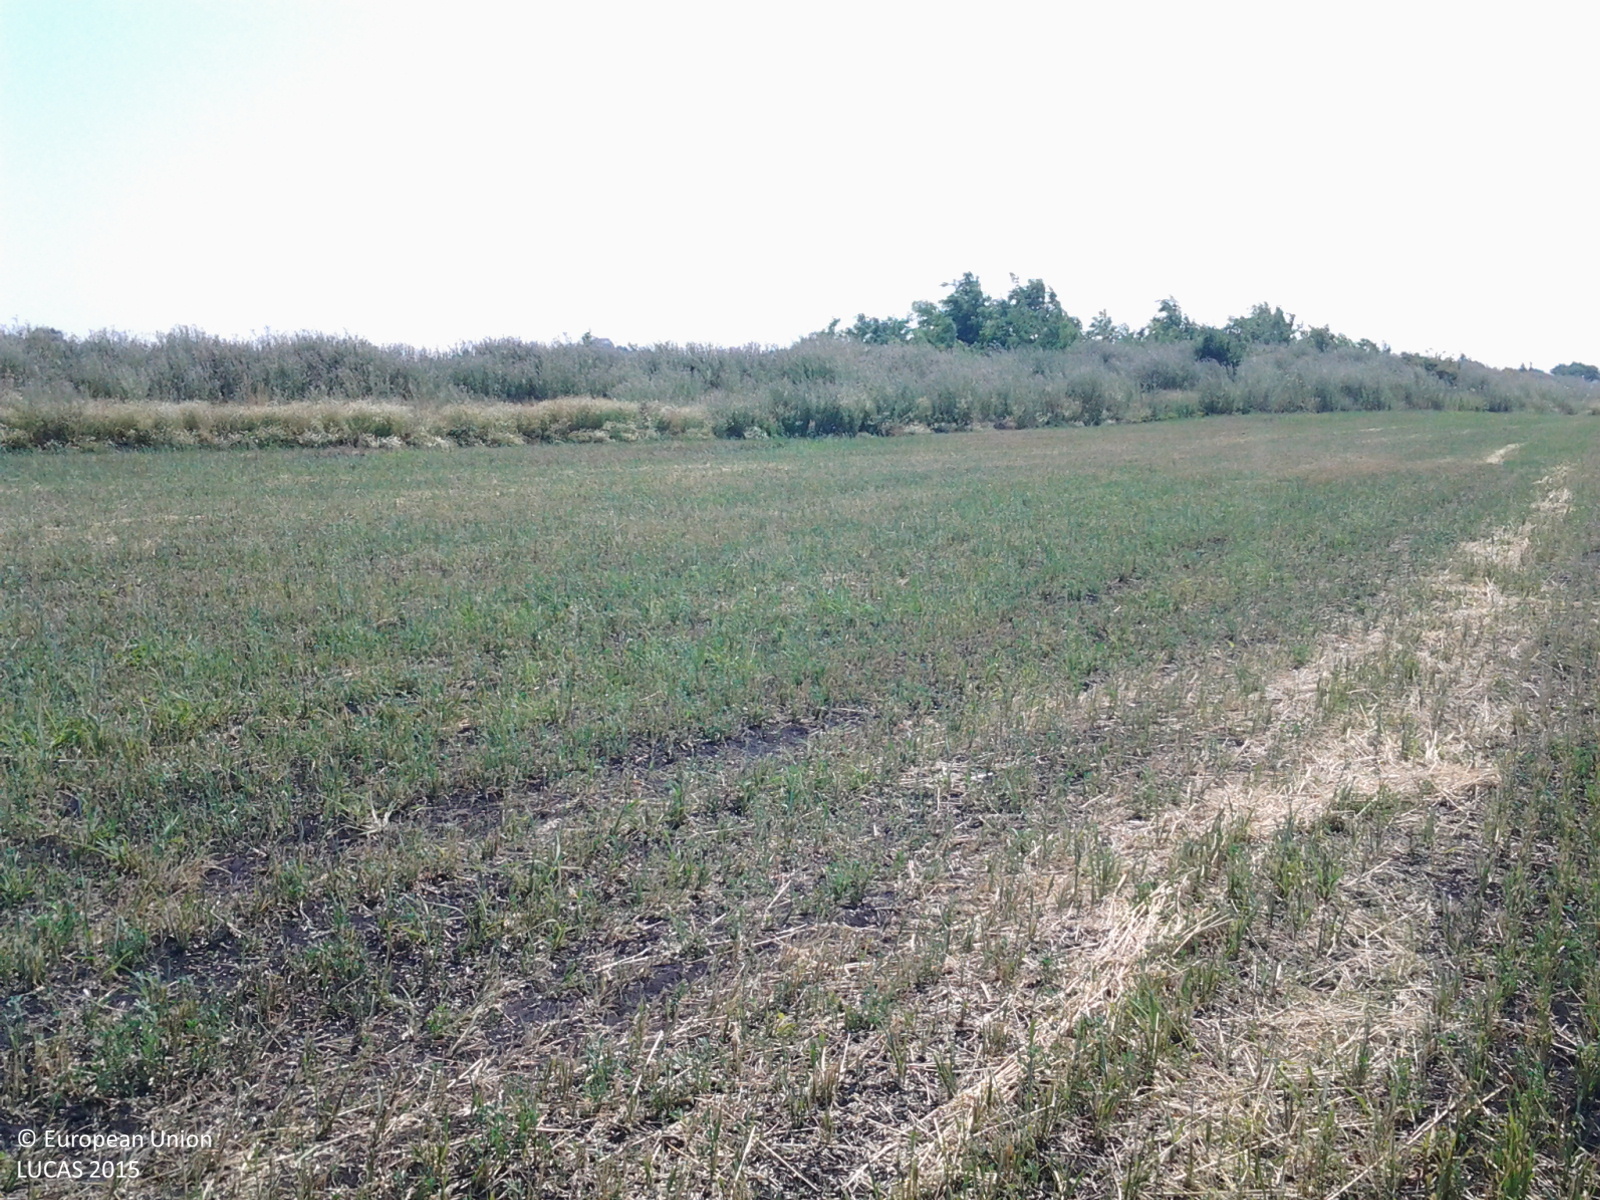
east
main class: Cropland
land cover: Oats
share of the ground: < 10 %
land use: Agriculture (excluding fallow land and kitchen gardens)
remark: Harvested field
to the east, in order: Oats; Spontaneously vegetated surfaces; Inland fresh running water; Grassland with sparse tree/shrub cover; Common wheat
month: July
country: HU
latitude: 47.4514
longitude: 20.2809
